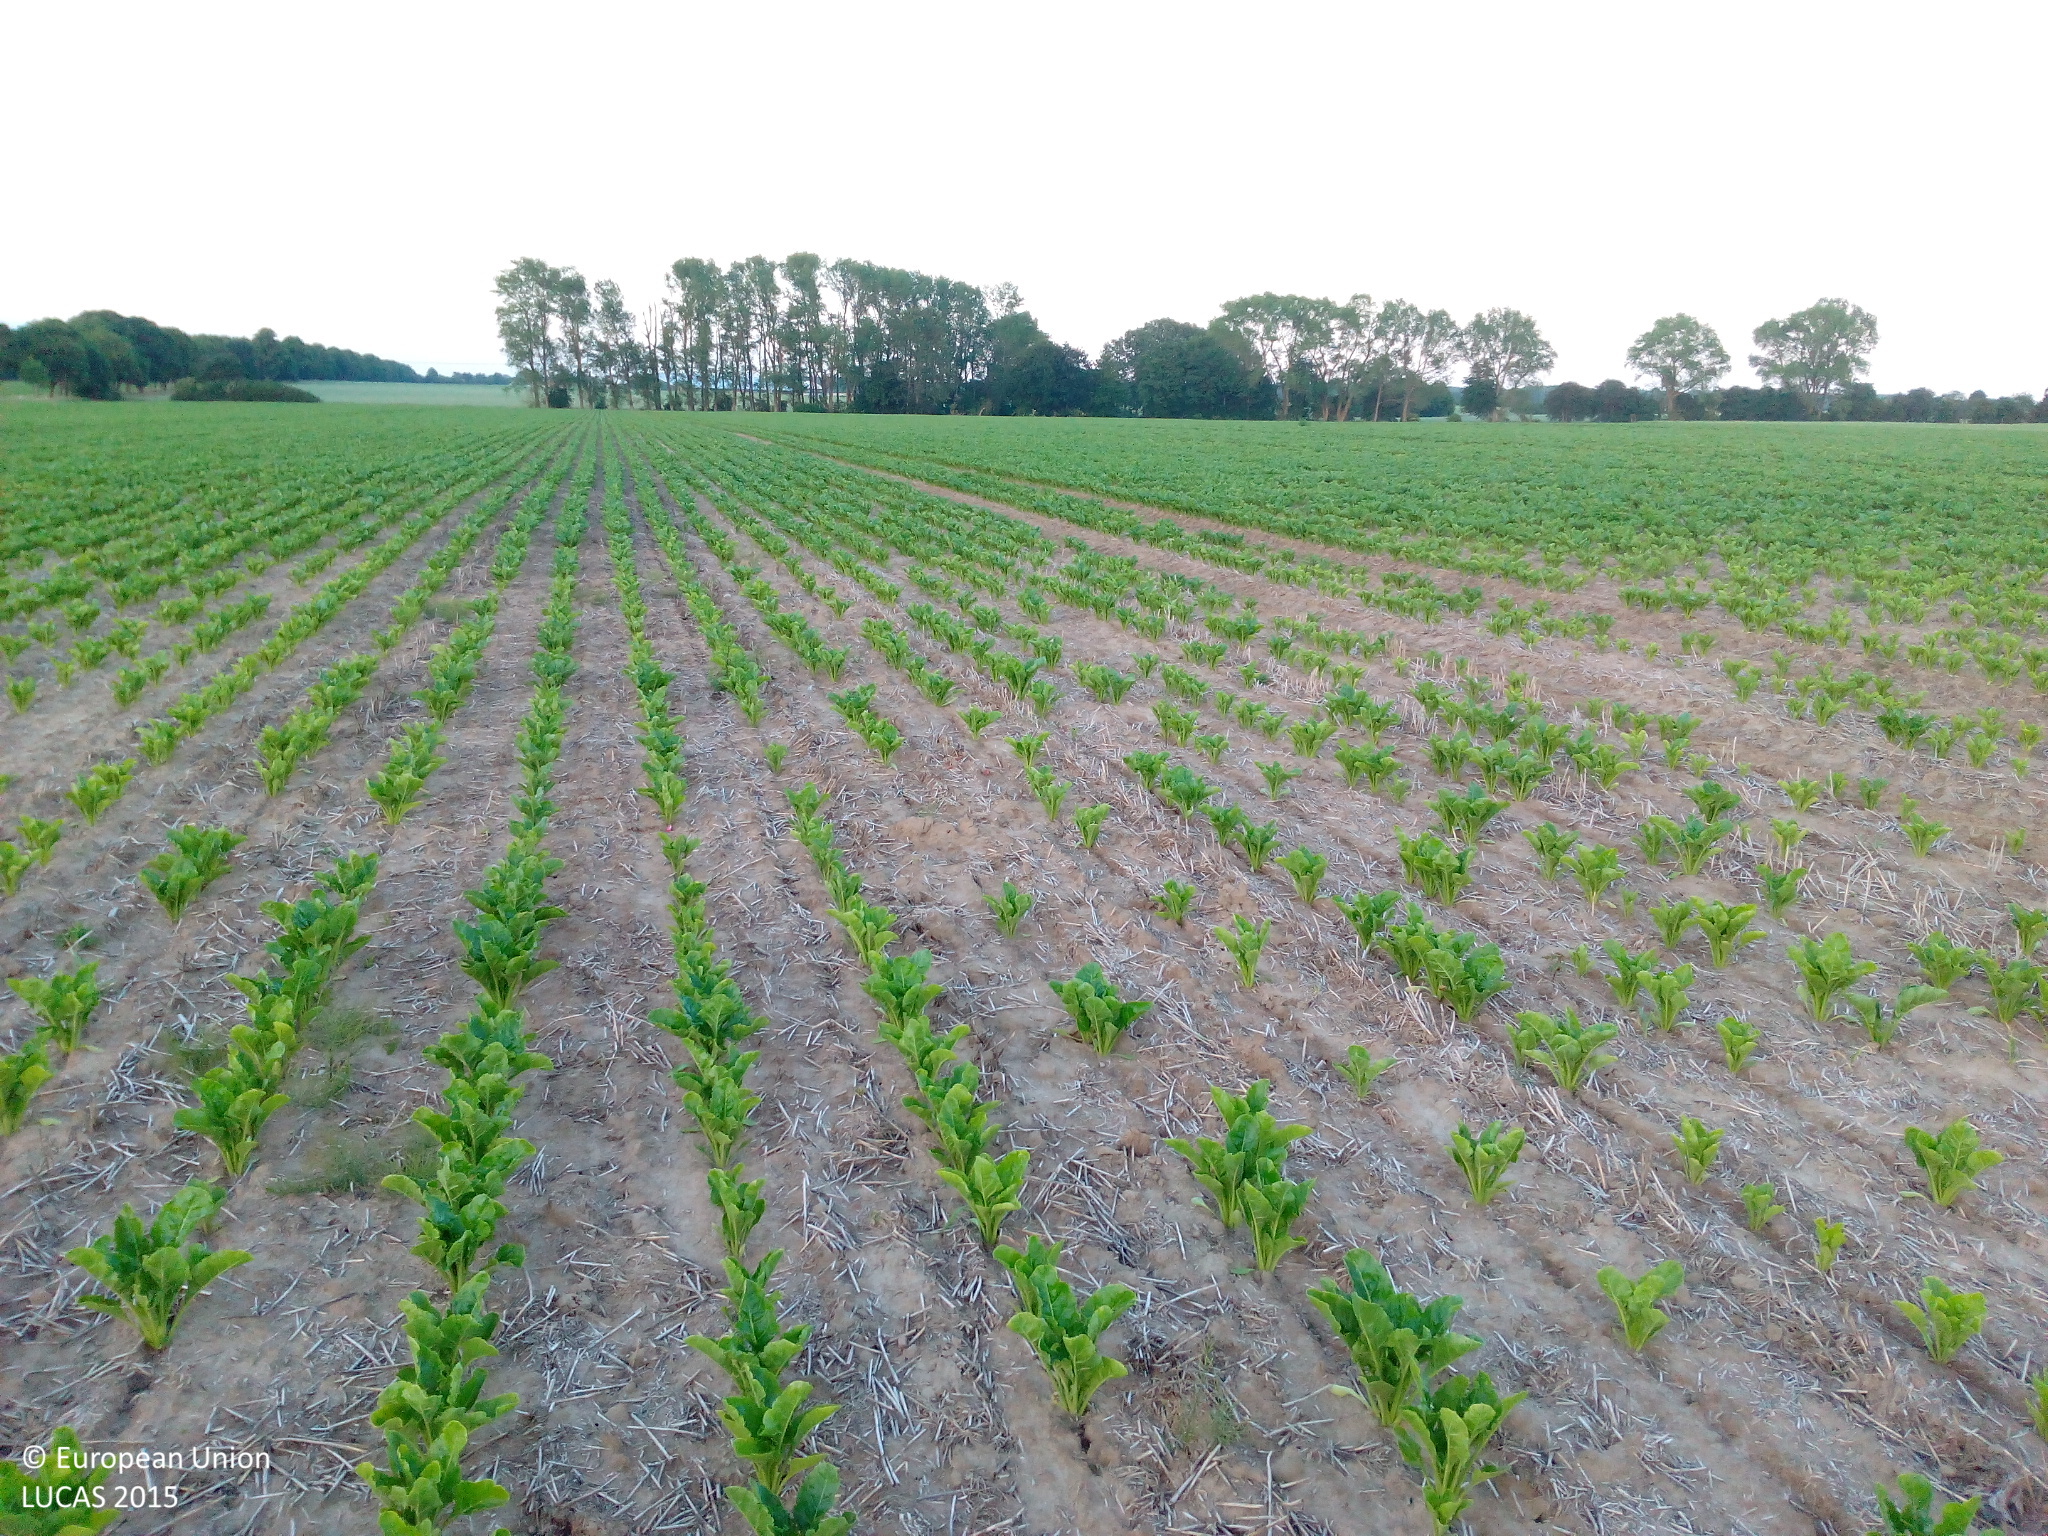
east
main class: Cropland
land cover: Sugar beet
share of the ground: < 10 %
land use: Agriculture (excluding fallow land and kitchen gardens)
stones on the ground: < 10 %
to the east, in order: Sugar beet
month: June
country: DE
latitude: 53.7019
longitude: 11.1658
